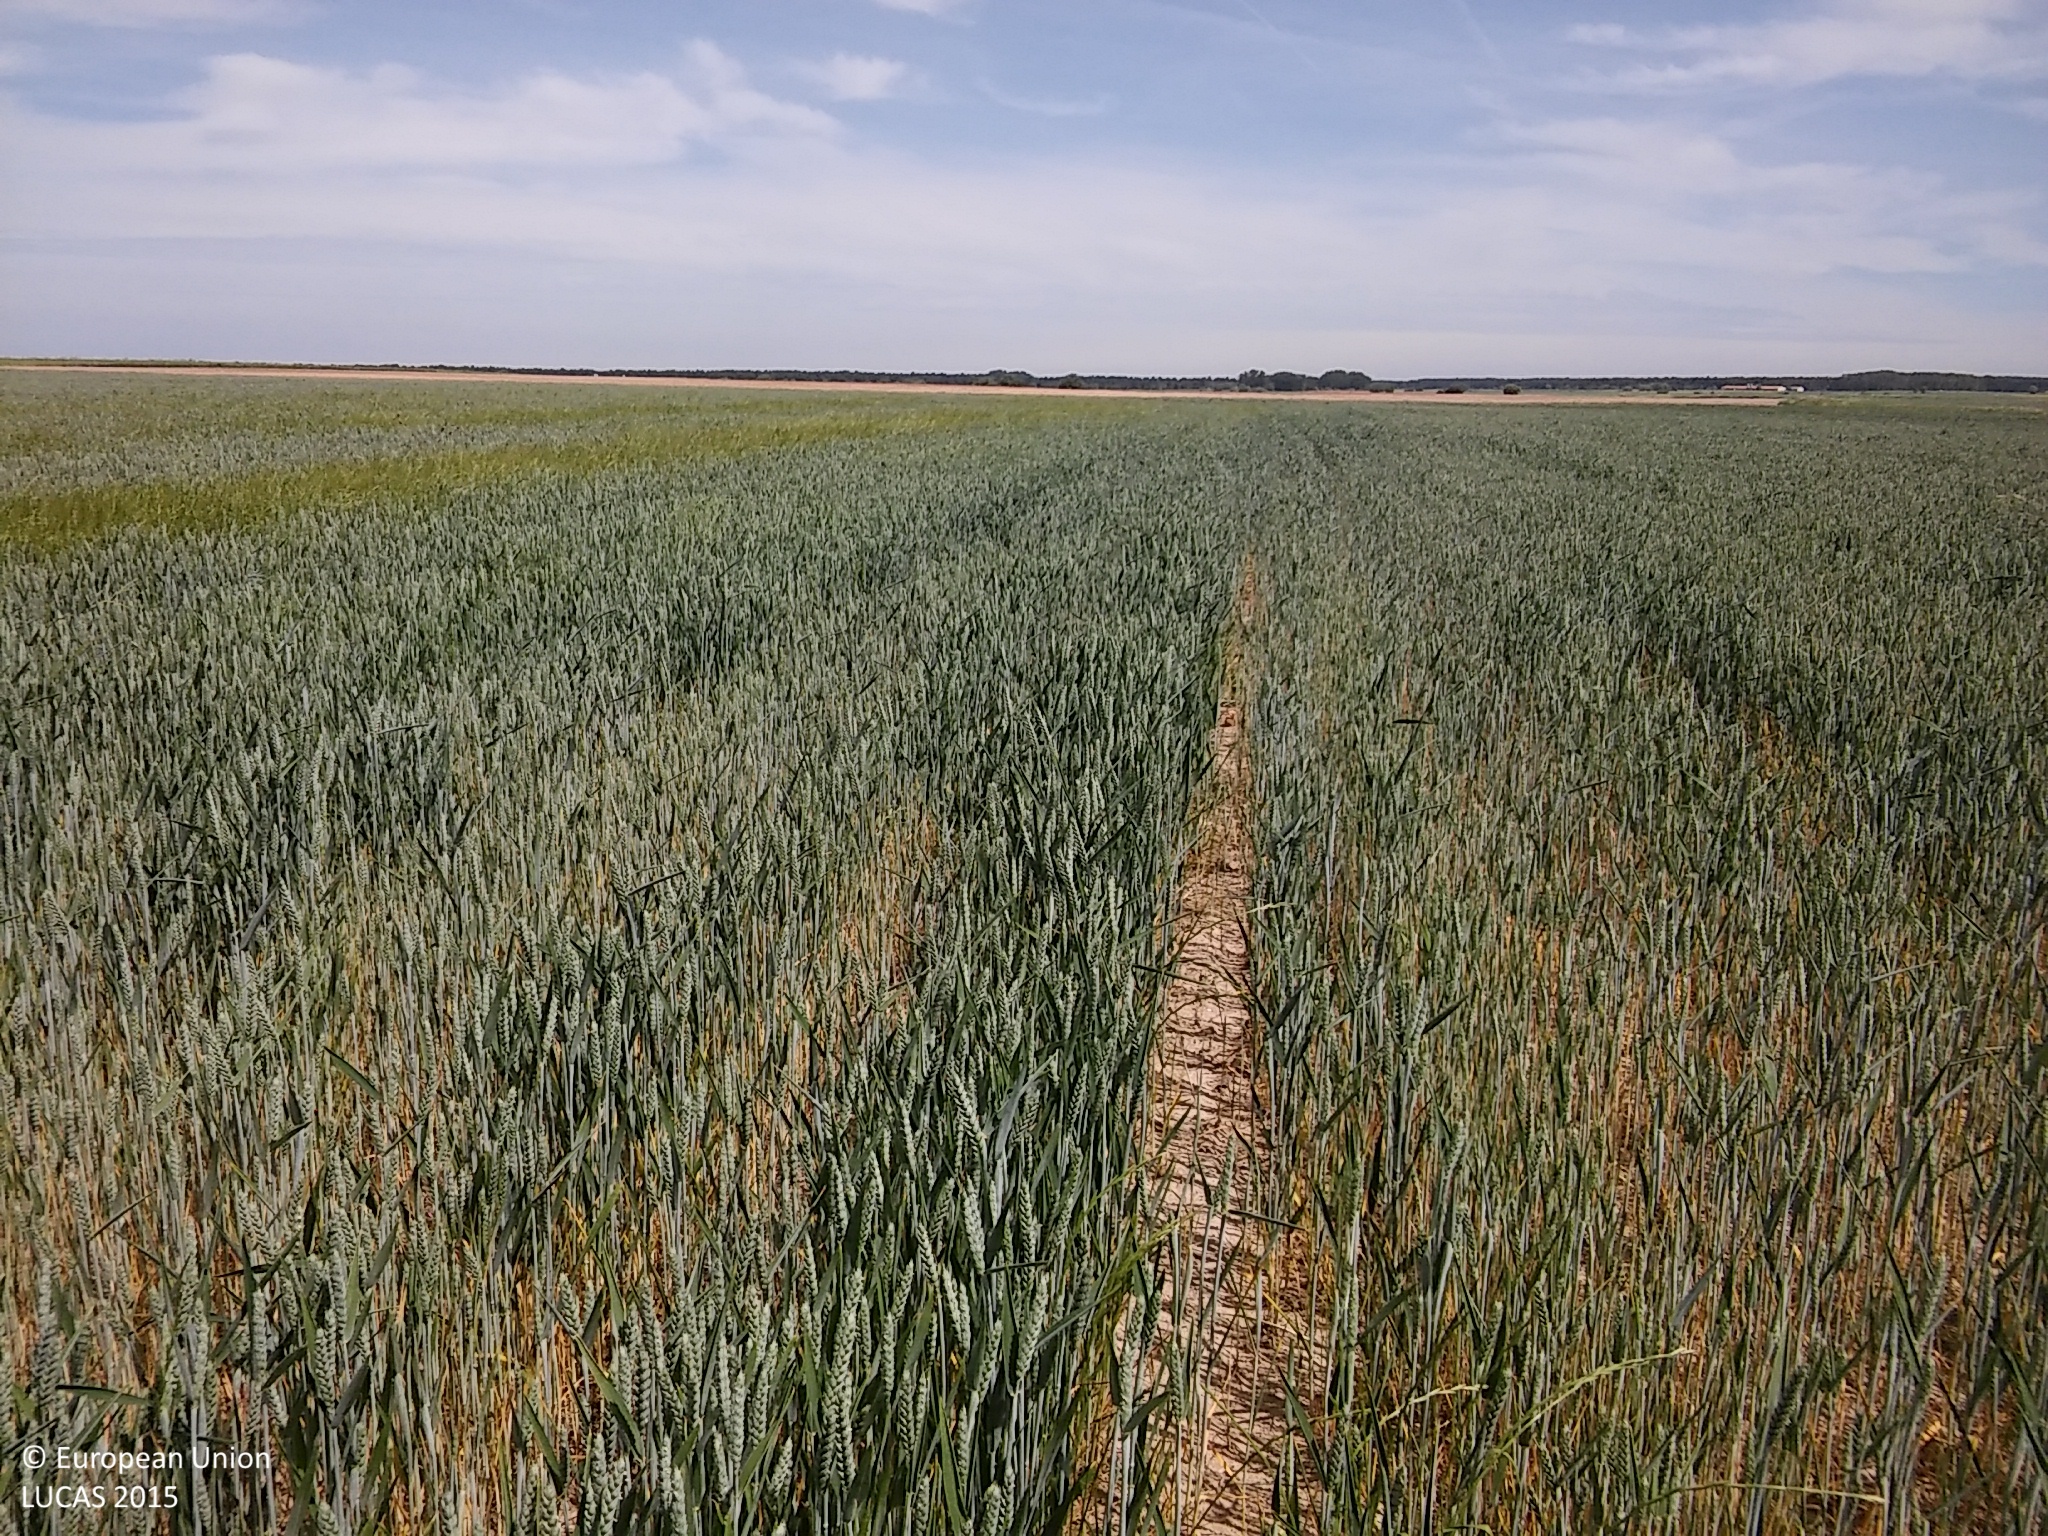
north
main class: Cropland
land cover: Common wheat
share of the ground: 50 - 75 %
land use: Agriculture (excluding fallow land and kitchen gardens)
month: May
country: ES
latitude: 41.1881
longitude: -4.0855
